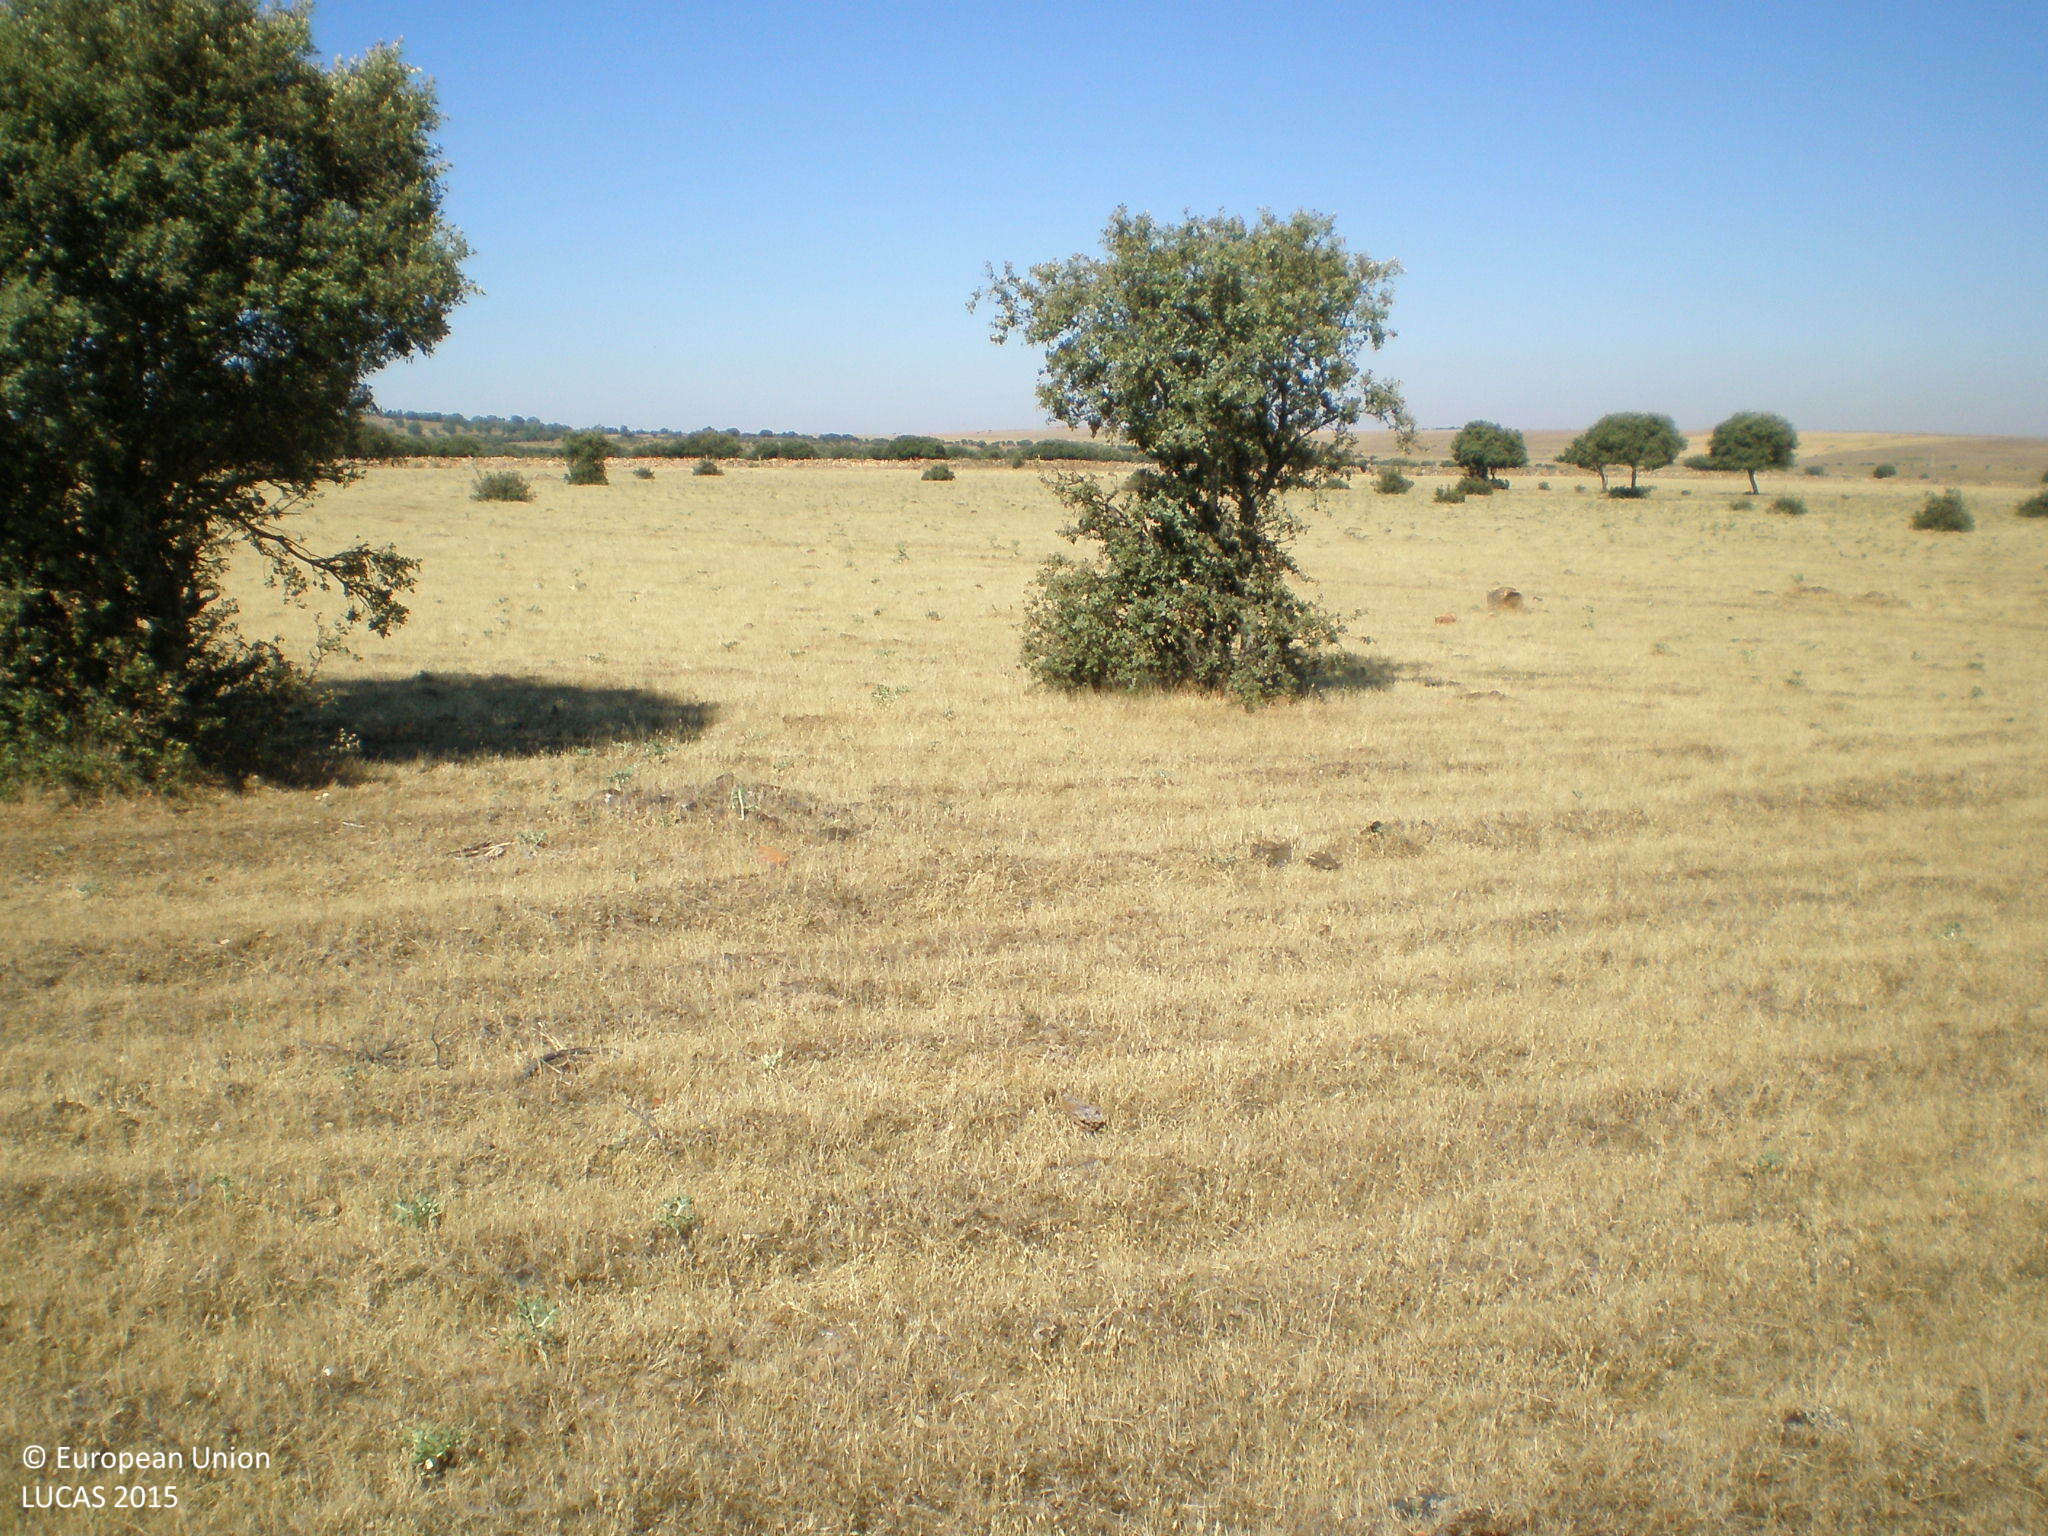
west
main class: Grassland
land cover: Grassland with sparse tree/shrub cover
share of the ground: > 75 %
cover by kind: herbaceous plants 95 %, broadleaved forest trees 5 %
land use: Agriculture (excluding fallow land and kitchen gardens)
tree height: < 5 m
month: June
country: ES
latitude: 40.7986
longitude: -5.6850
